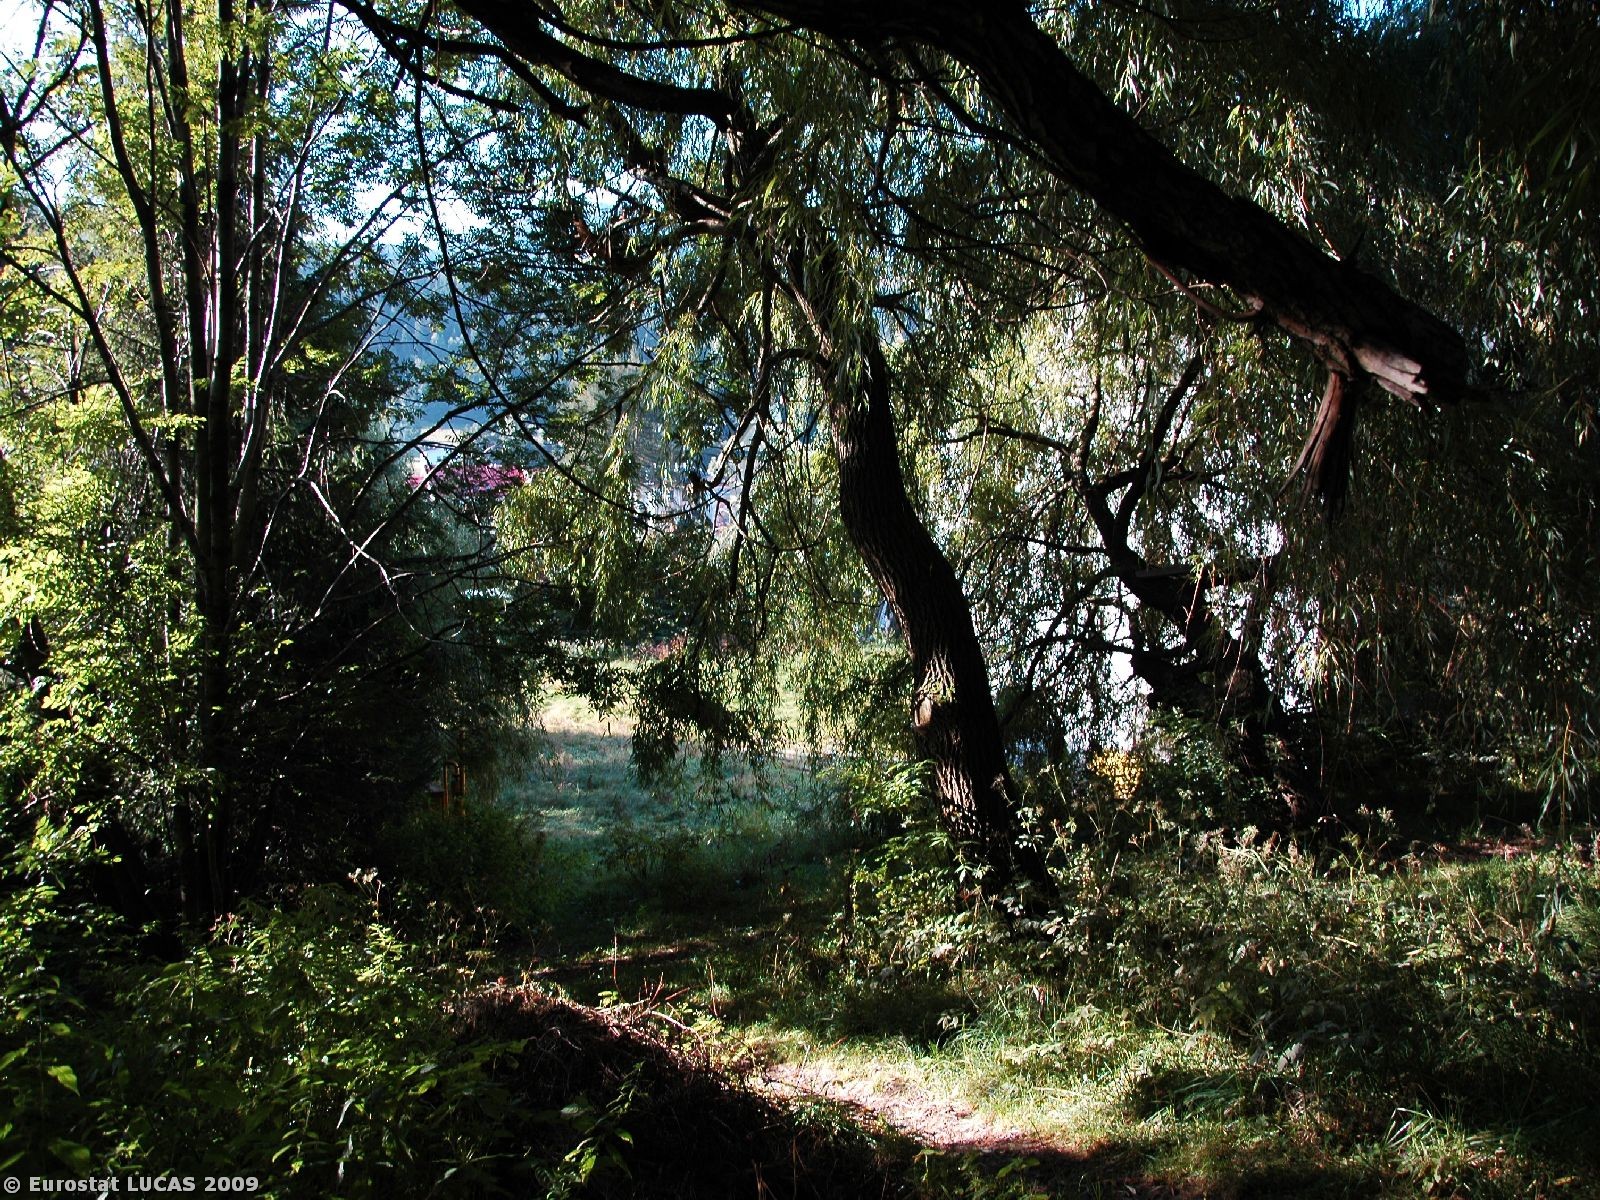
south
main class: Woodland
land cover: Broadleaved woodland
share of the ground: > 75 %
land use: Unused
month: September
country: PL
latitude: 49.7172
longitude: 19.0242
